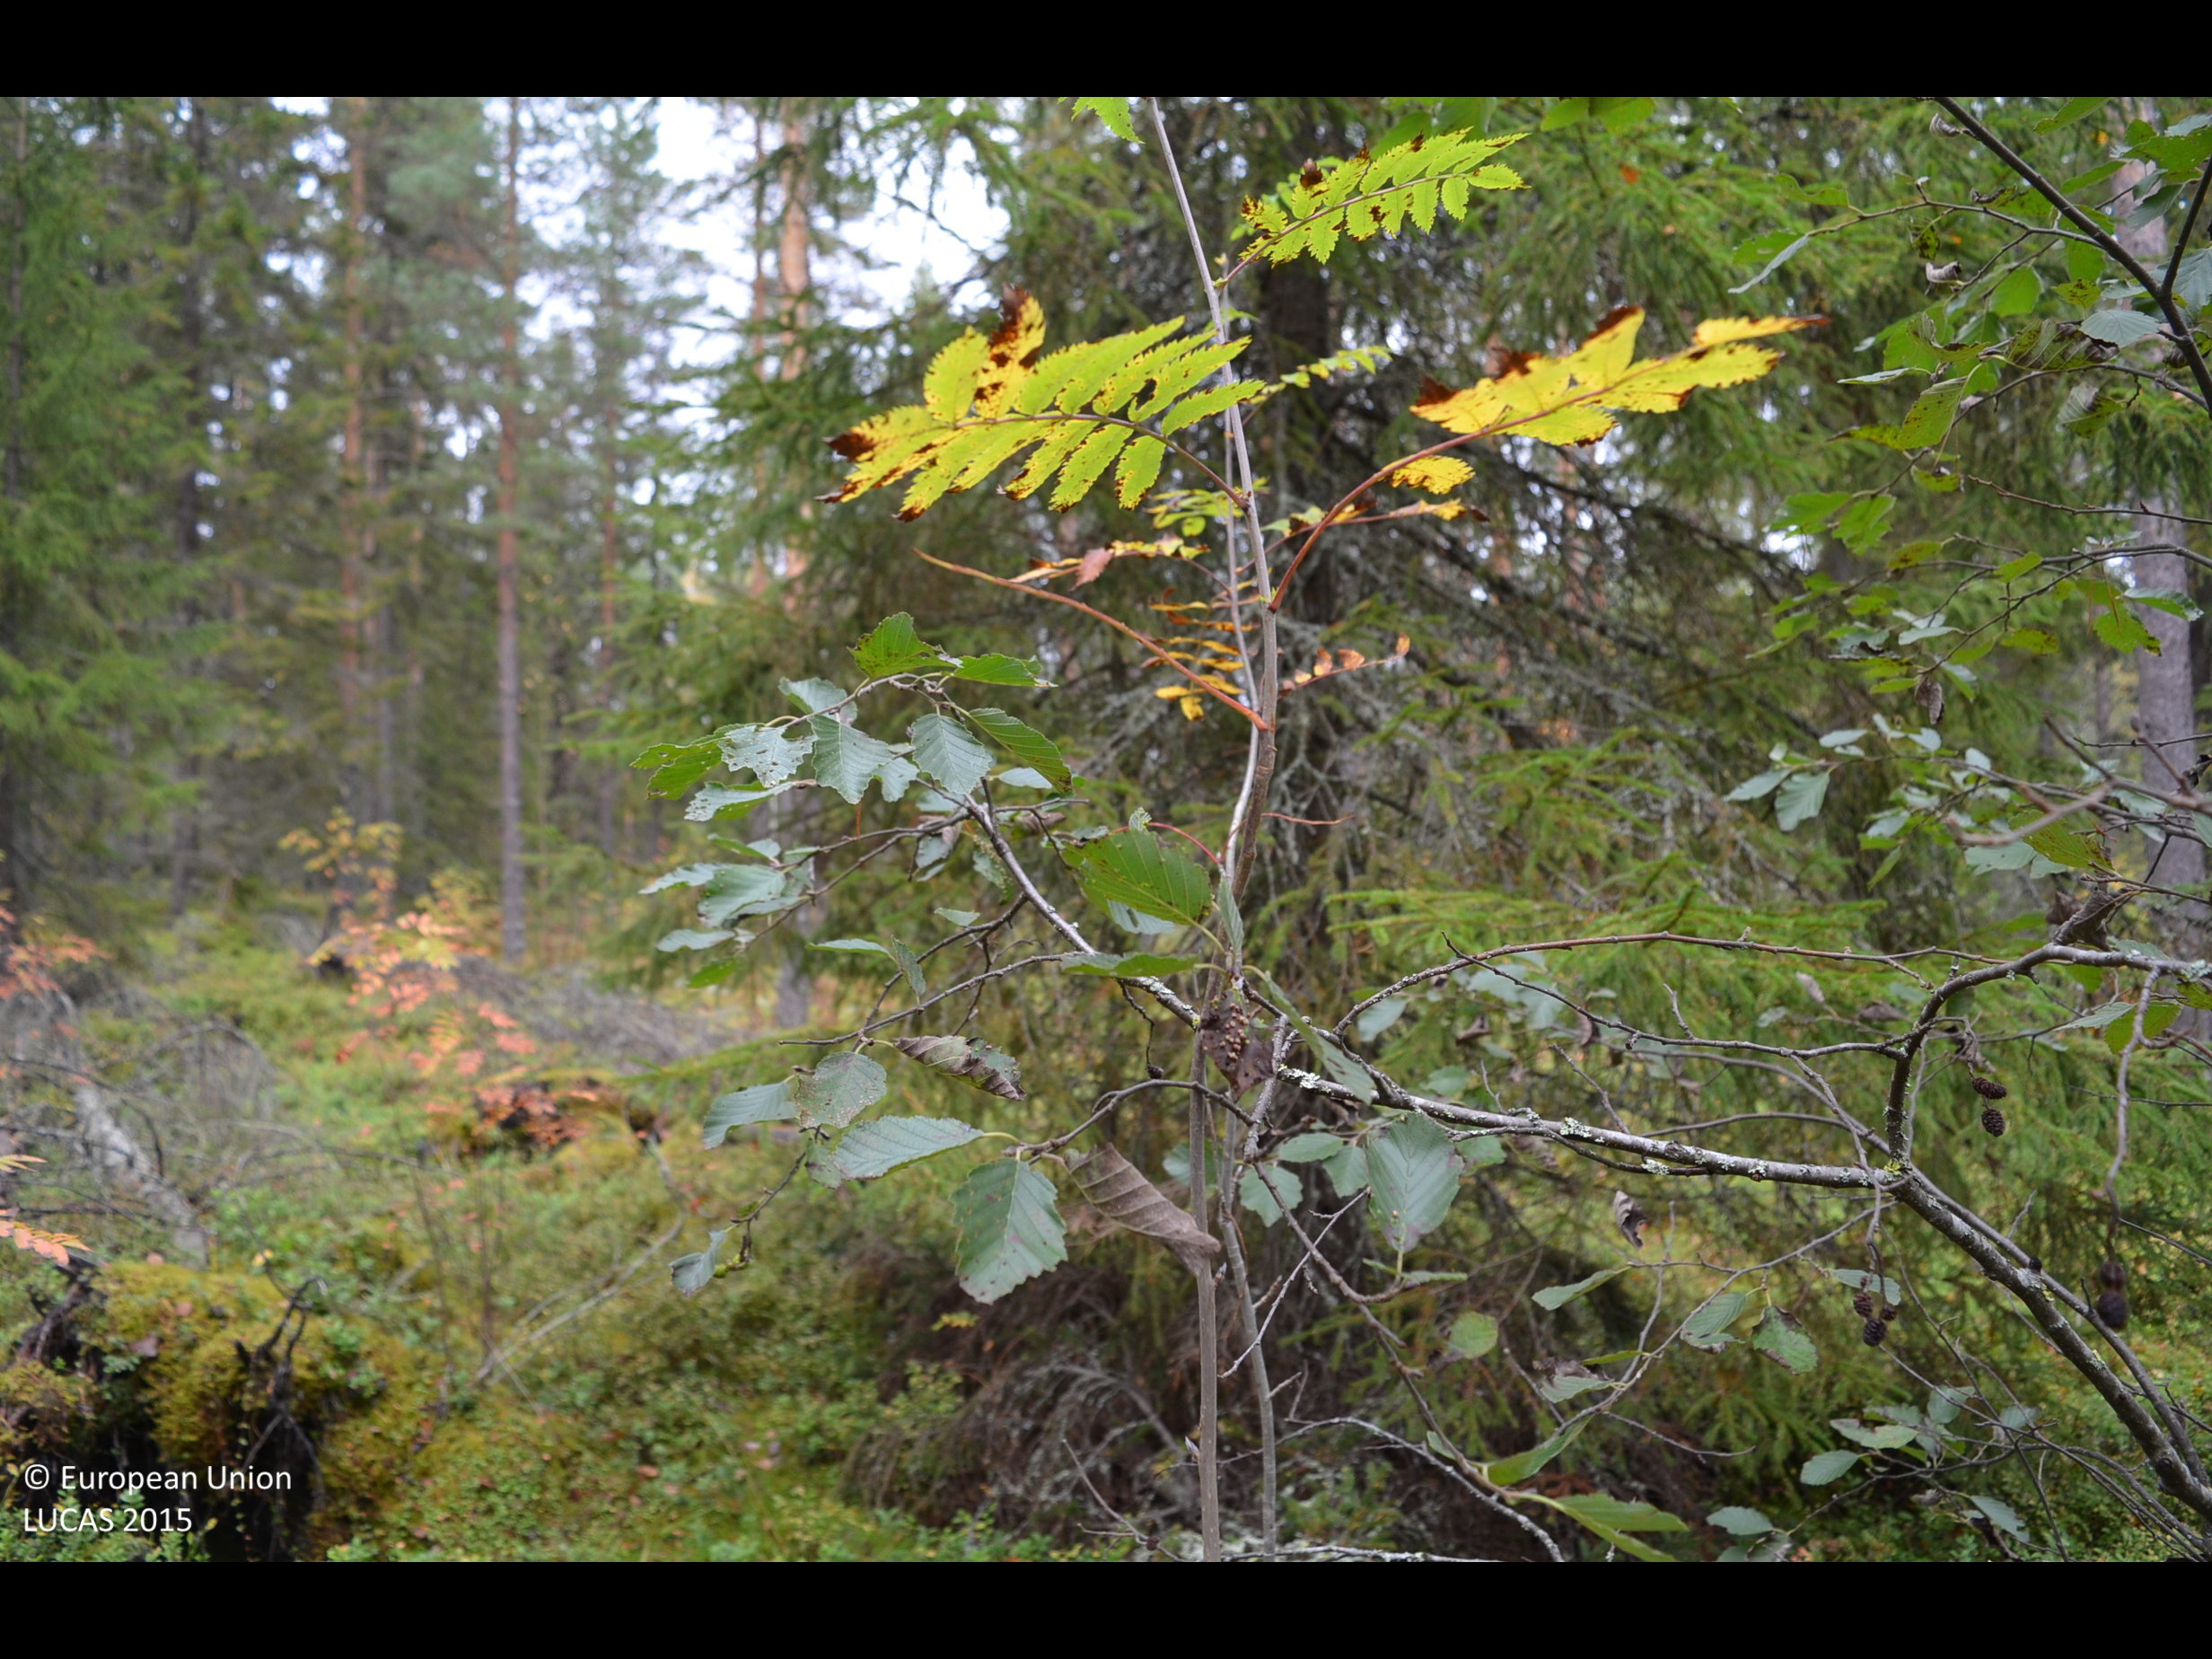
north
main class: Woodland
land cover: Other mixed woodland
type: boreal forest
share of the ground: 50 - 75 %
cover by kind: coniferous forest trees 50 %, broadleaved forest trees 20 %, shrubs 20 %, lichens and mosses 10 %
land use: Forestry
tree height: > 5 m
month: September
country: FI
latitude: 62.5683
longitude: 23.7136
